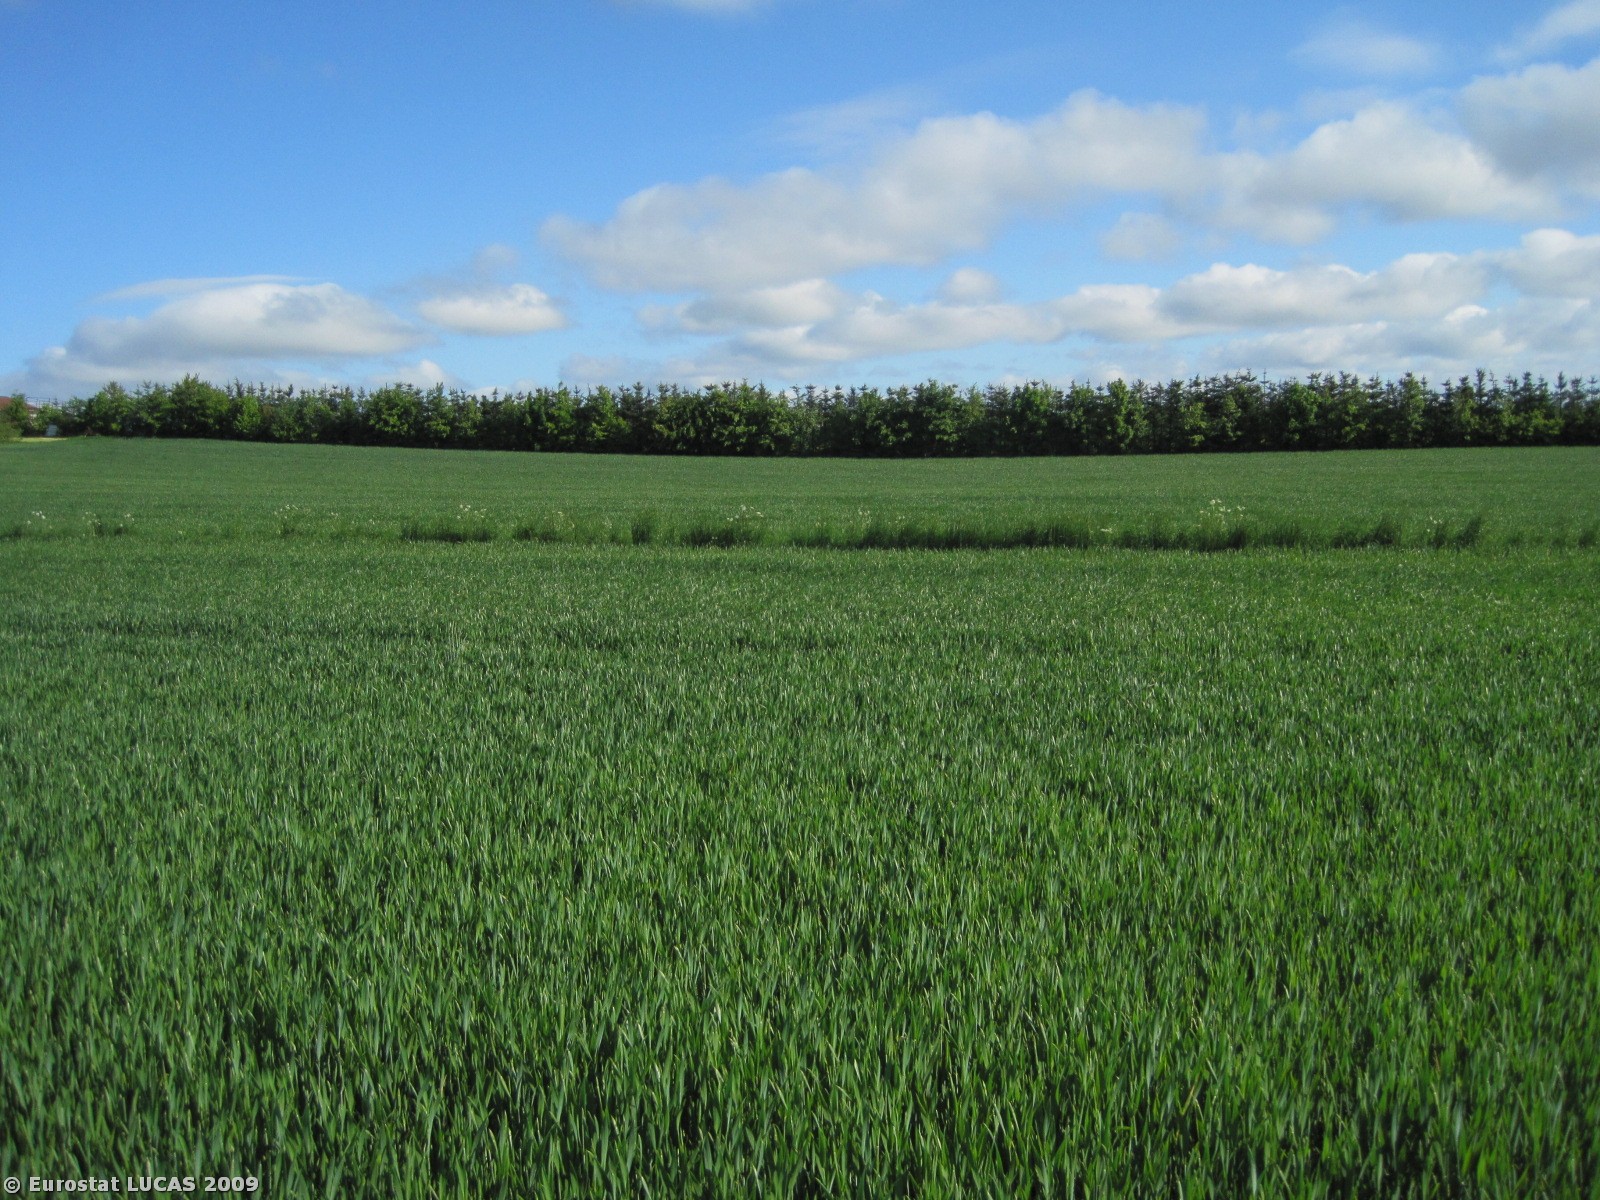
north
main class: Cropland
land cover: Common wheat
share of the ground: > 75 %
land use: Agriculture (excluding fallow land and kitchen gardens)
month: May
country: DK
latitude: 56.8708
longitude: 10.0164
